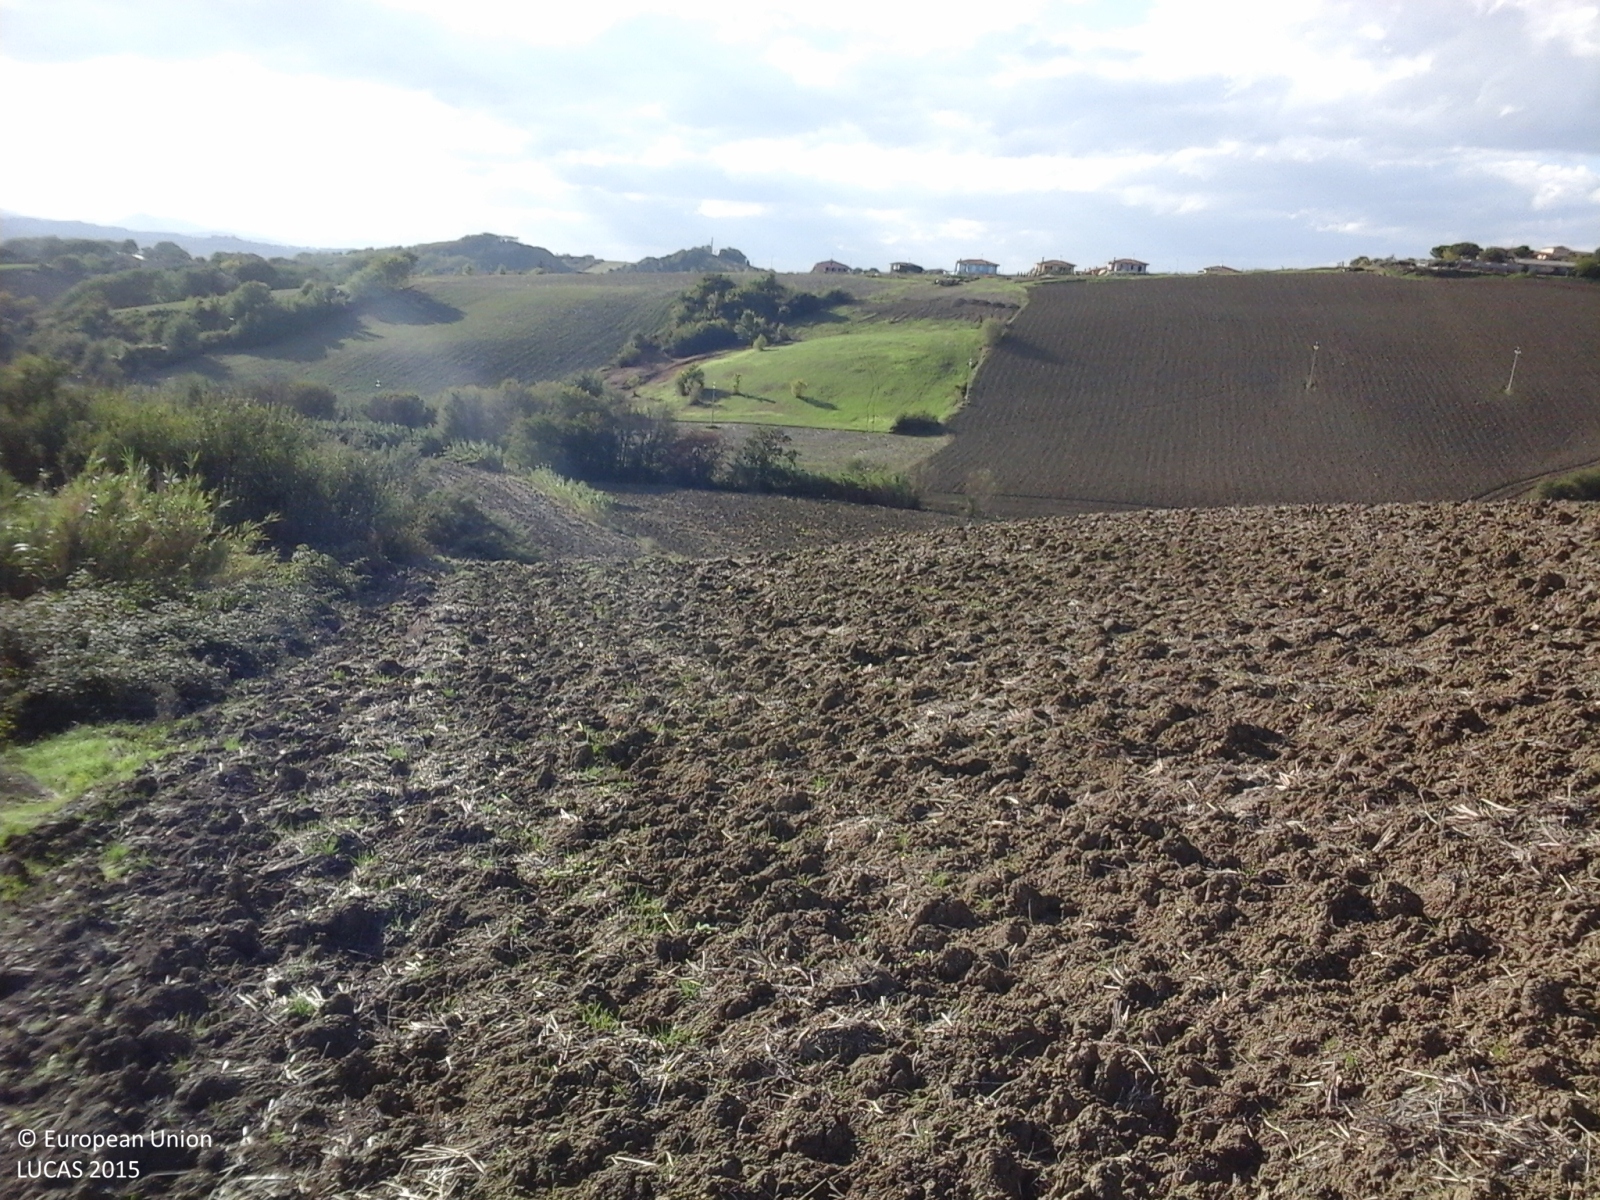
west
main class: Cropland
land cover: Durum wheat
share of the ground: < 10 %
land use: Agriculture (excluding fallow land and kitchen gardens)
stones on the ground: < 10 %
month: October
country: IT
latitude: 43.5367
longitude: 13.3949
